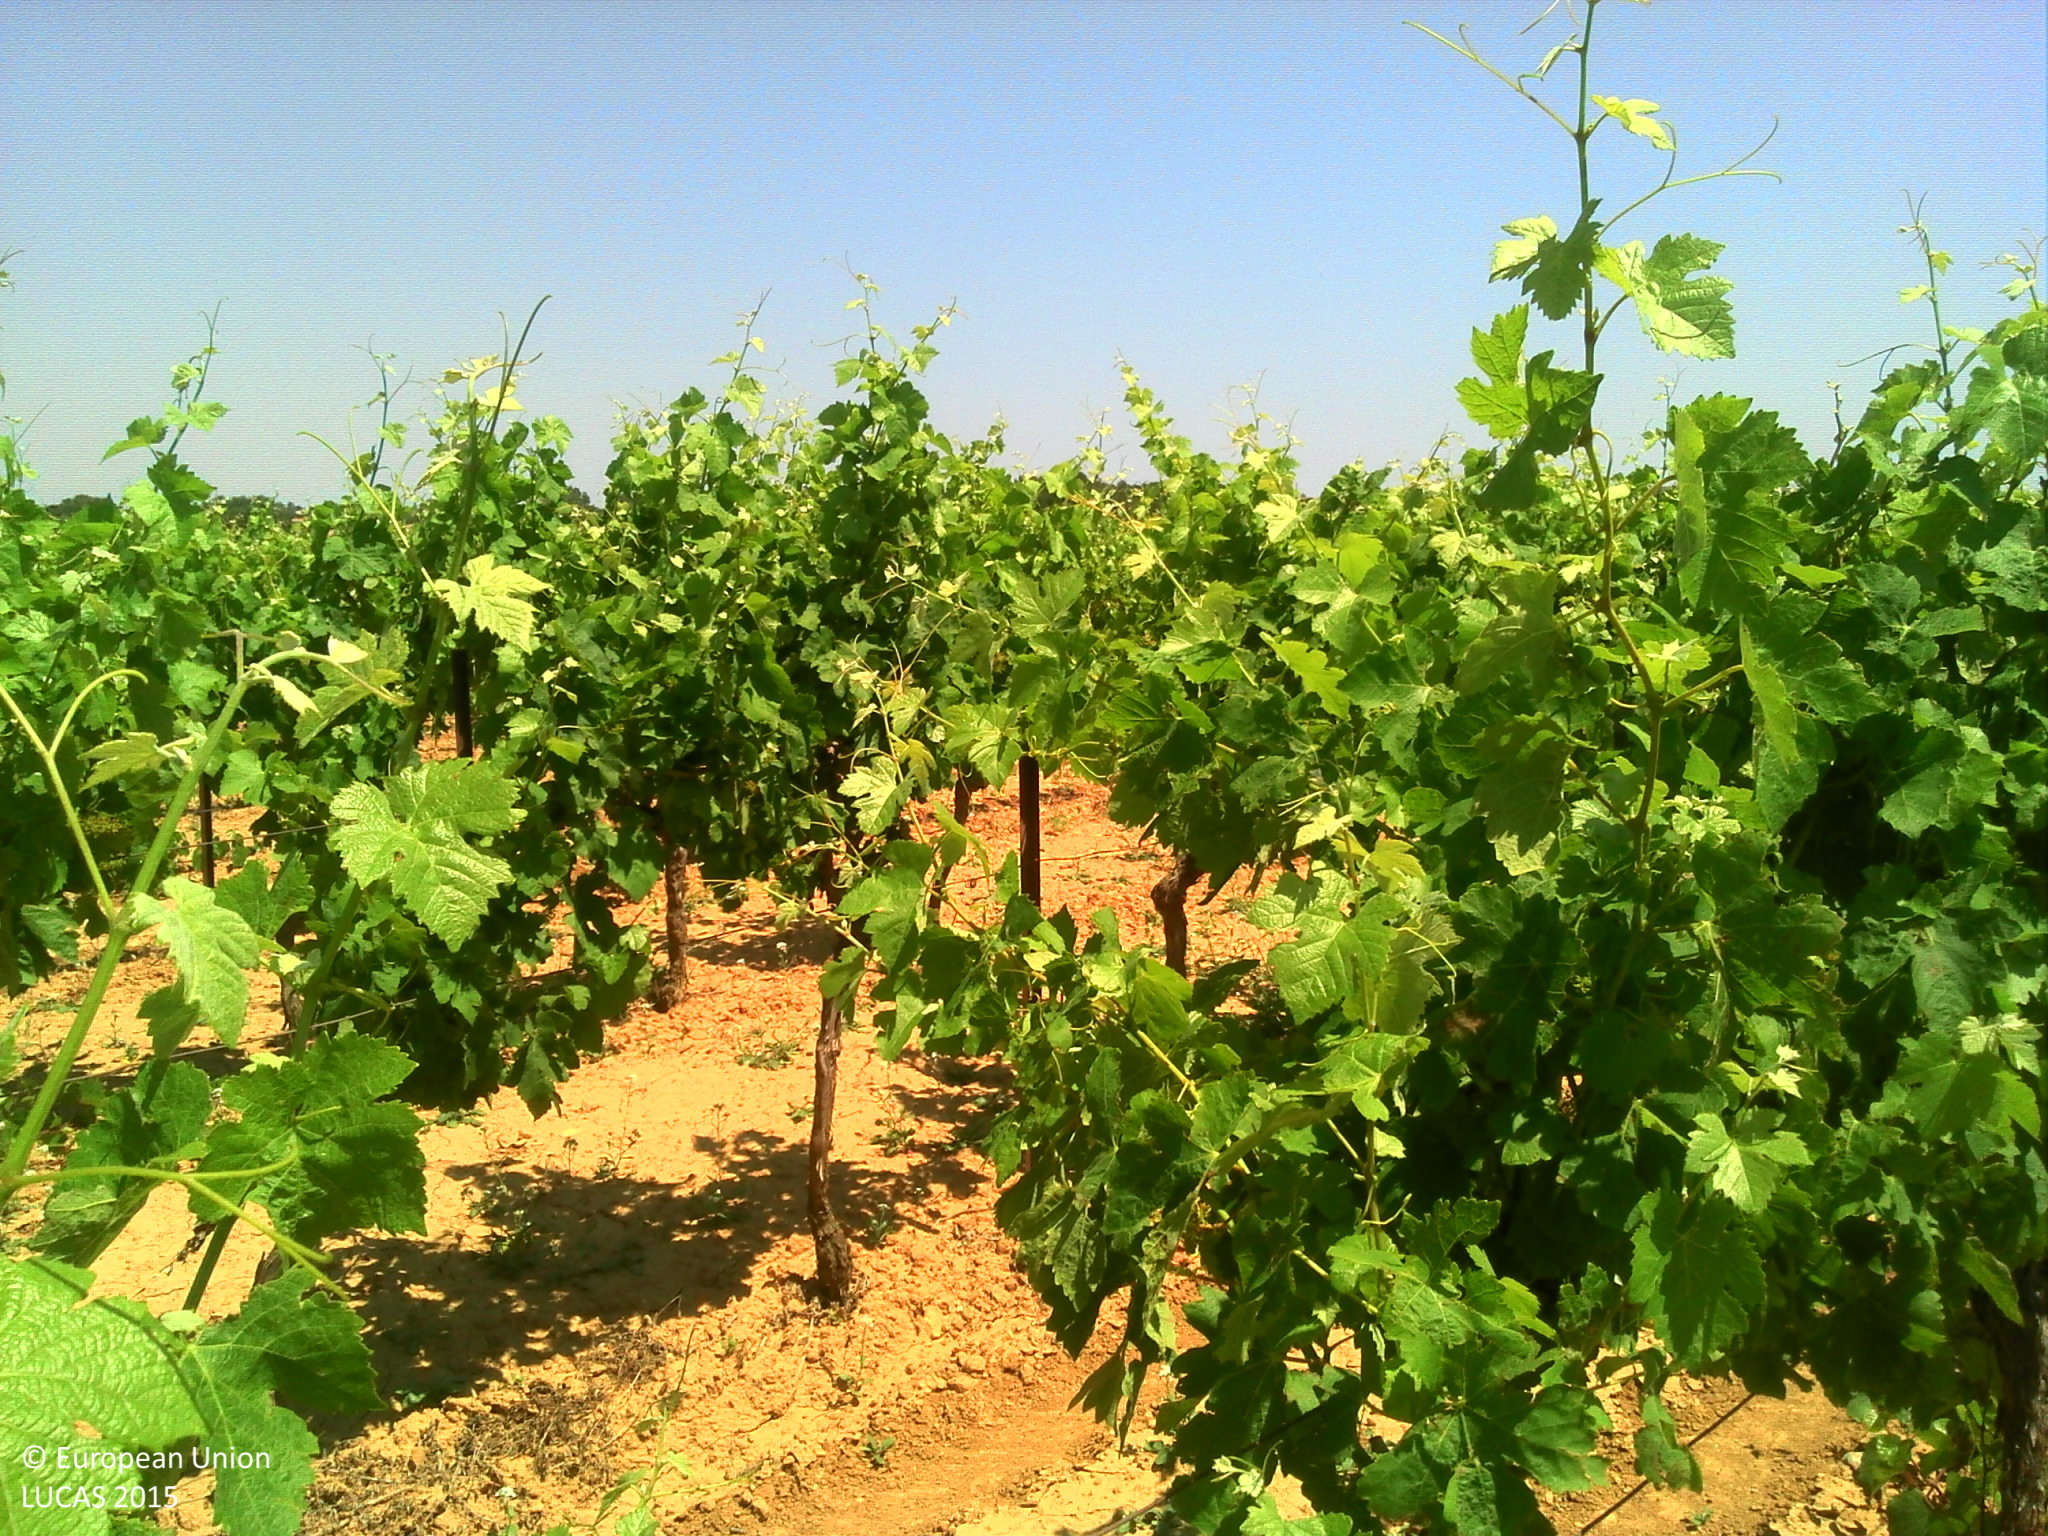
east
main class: Cropland
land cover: Vineyards
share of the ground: > 75 %
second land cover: Other bare soil
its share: > 75 %
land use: Agriculture (excluding fallow land and kitchen gardens)
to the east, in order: Vineyards; Other bare soil; Tracks; Vineyards
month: June
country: FR
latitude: 43.2338
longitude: 3.1018
